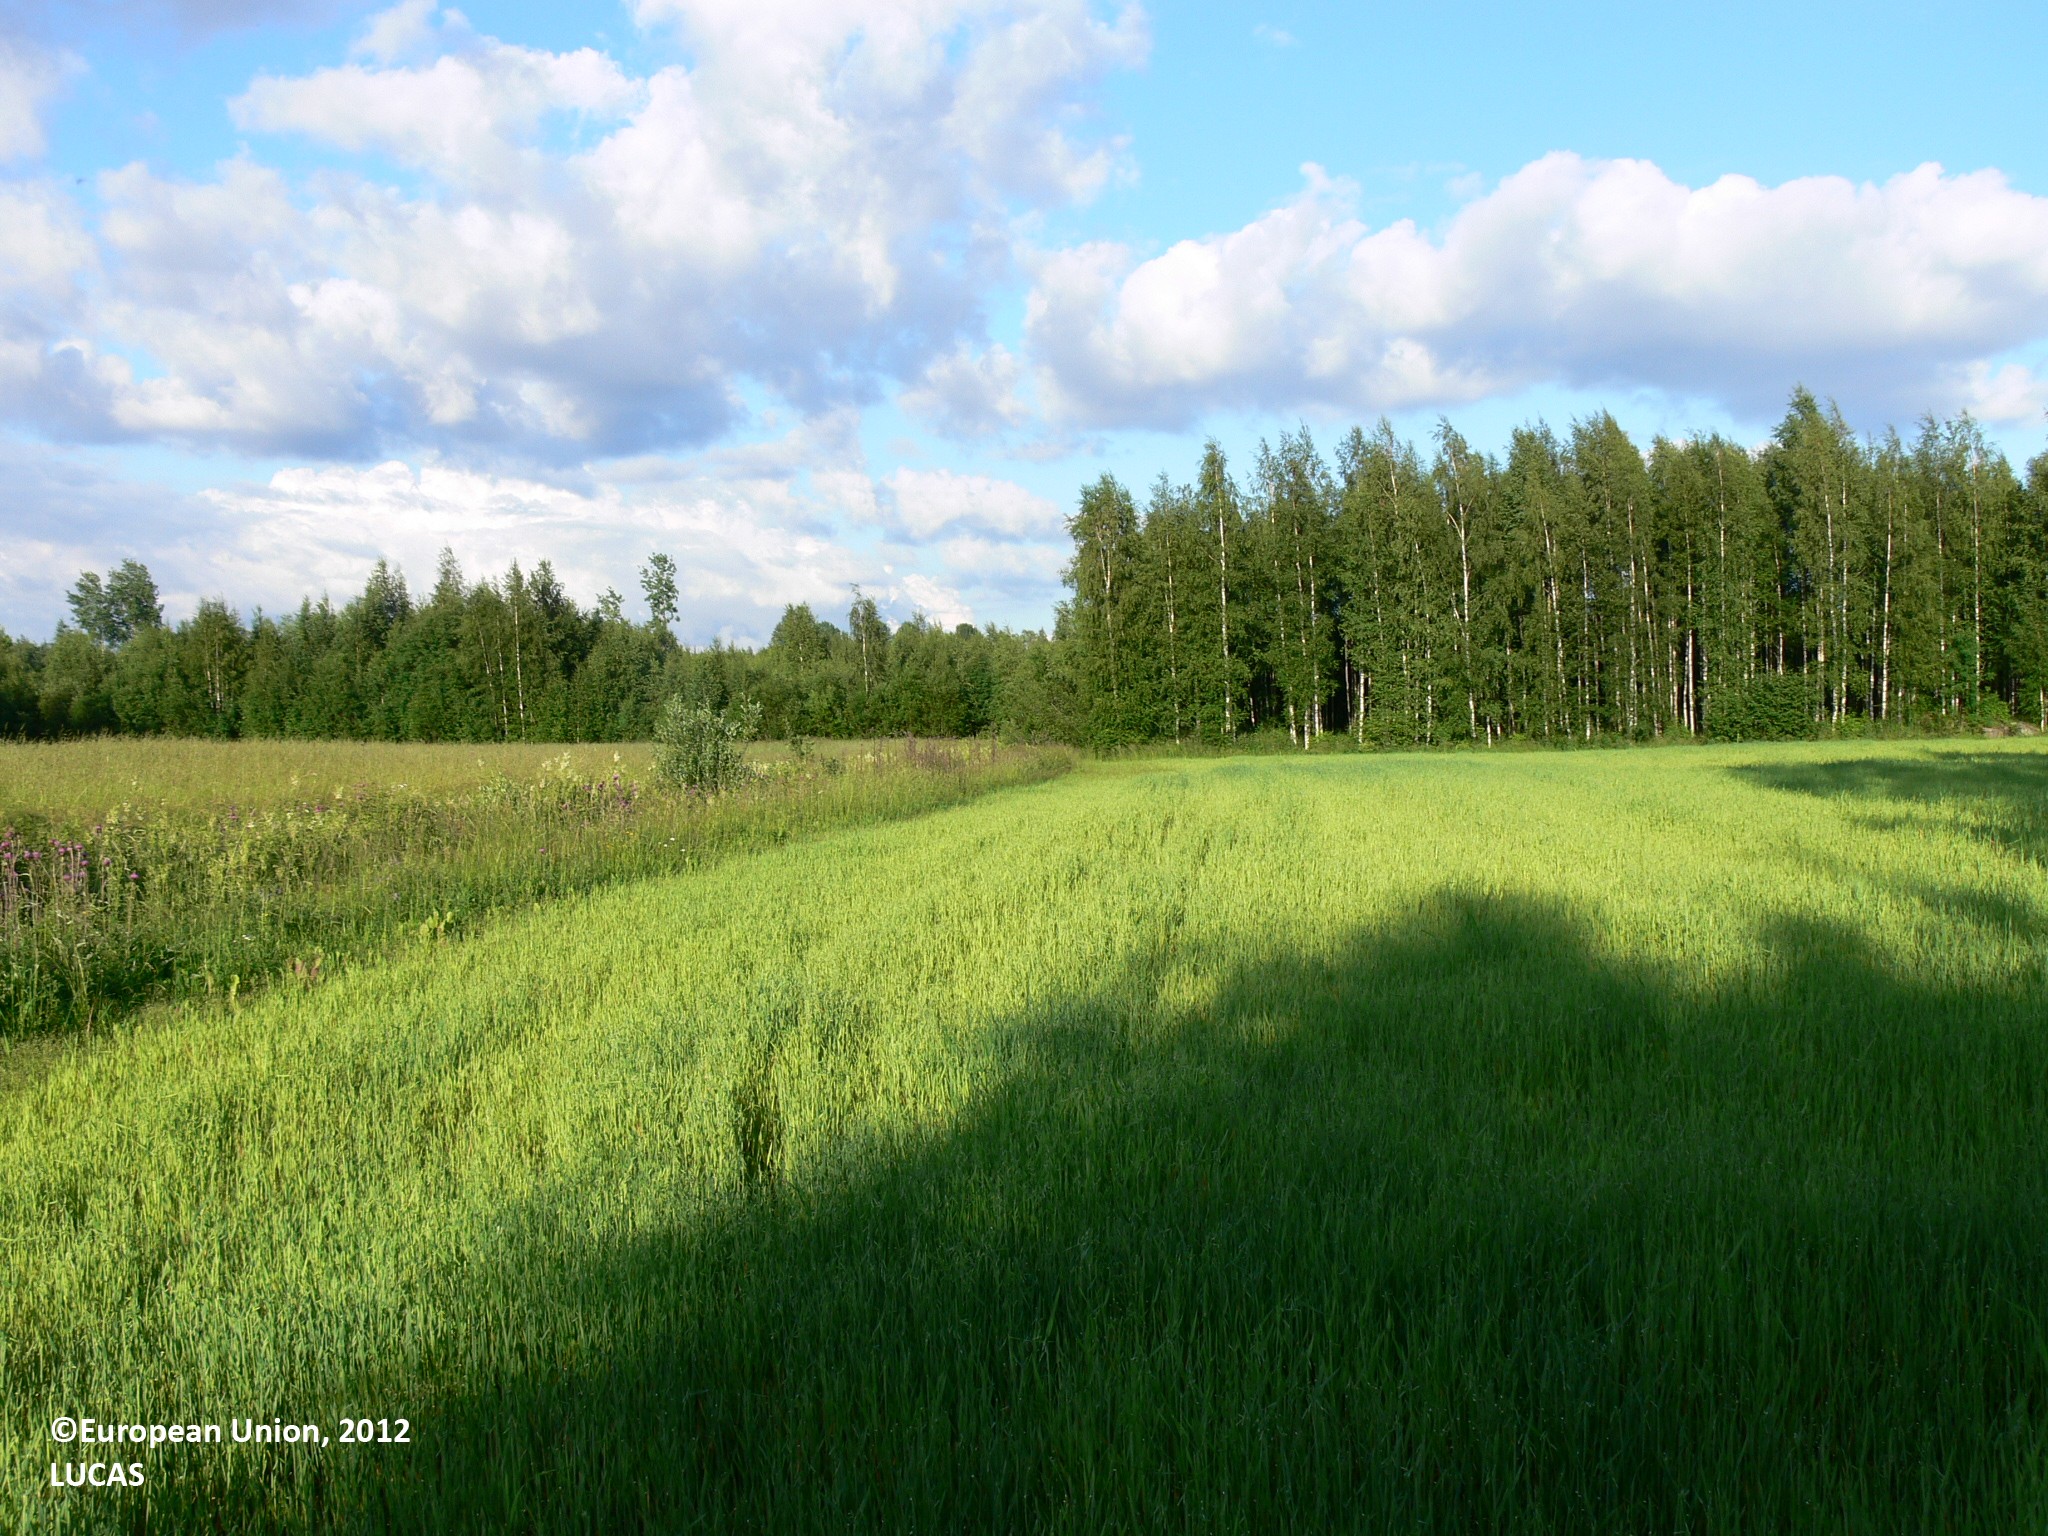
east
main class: Cropland
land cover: Oats
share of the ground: > 75 %
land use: Agriculture (excluding fallow land and kitchen gardens)
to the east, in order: Oats; Grass margins; Ditches and canals; Grass margins; Spontaneously vegetated surfaces; Grass margins; Ditches and canals; Grass margins; Broadleaved woodland; Spruce dominated mixed woodland; Ditches and canals; Spruce dominated mixed woodland; Ditches and canals; Broadleaved woodland; Ditches and canals; Spruce dominated mixed woodland
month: July
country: FI
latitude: 62.3027
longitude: 29.3876
